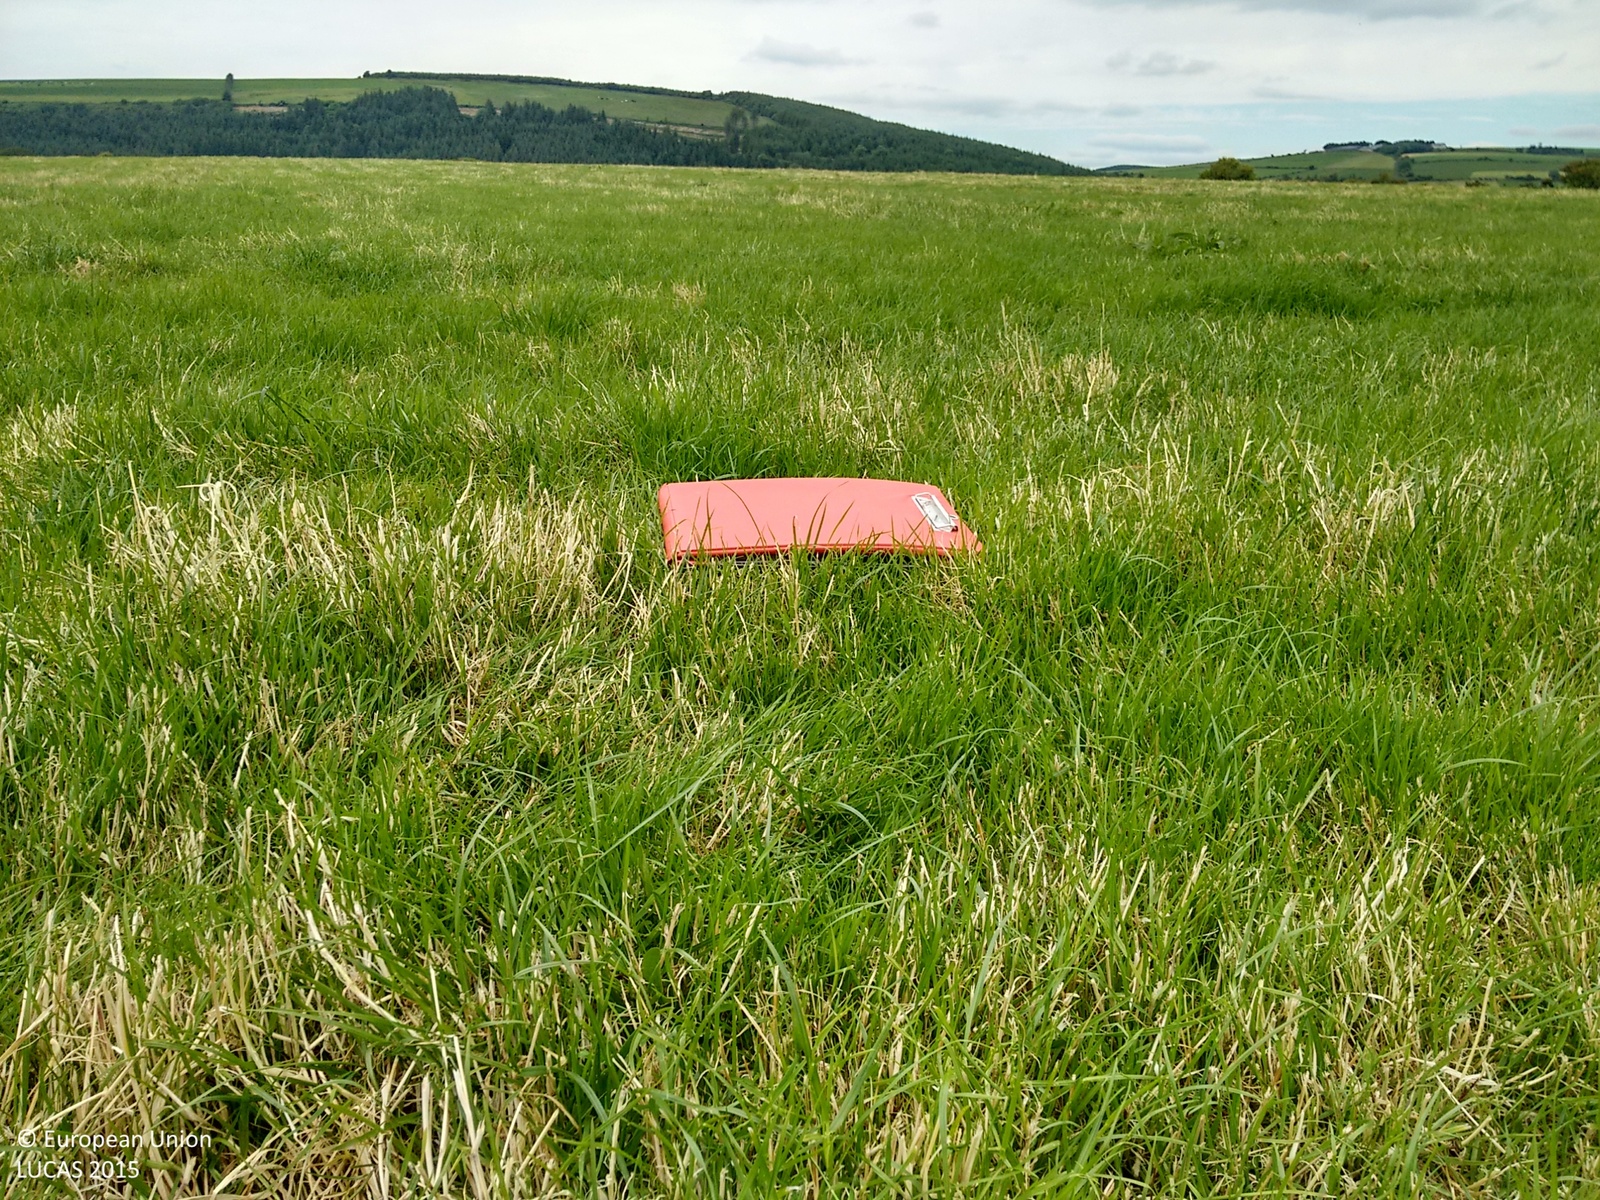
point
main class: Grassland
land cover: Grassland without tree/shrub cover
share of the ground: > 75 %
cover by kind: herbaceous plants 100 %
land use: Agriculture (excluding fallow land and kitchen gardens)
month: June
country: IE
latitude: 51.6662
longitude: -8.8135
